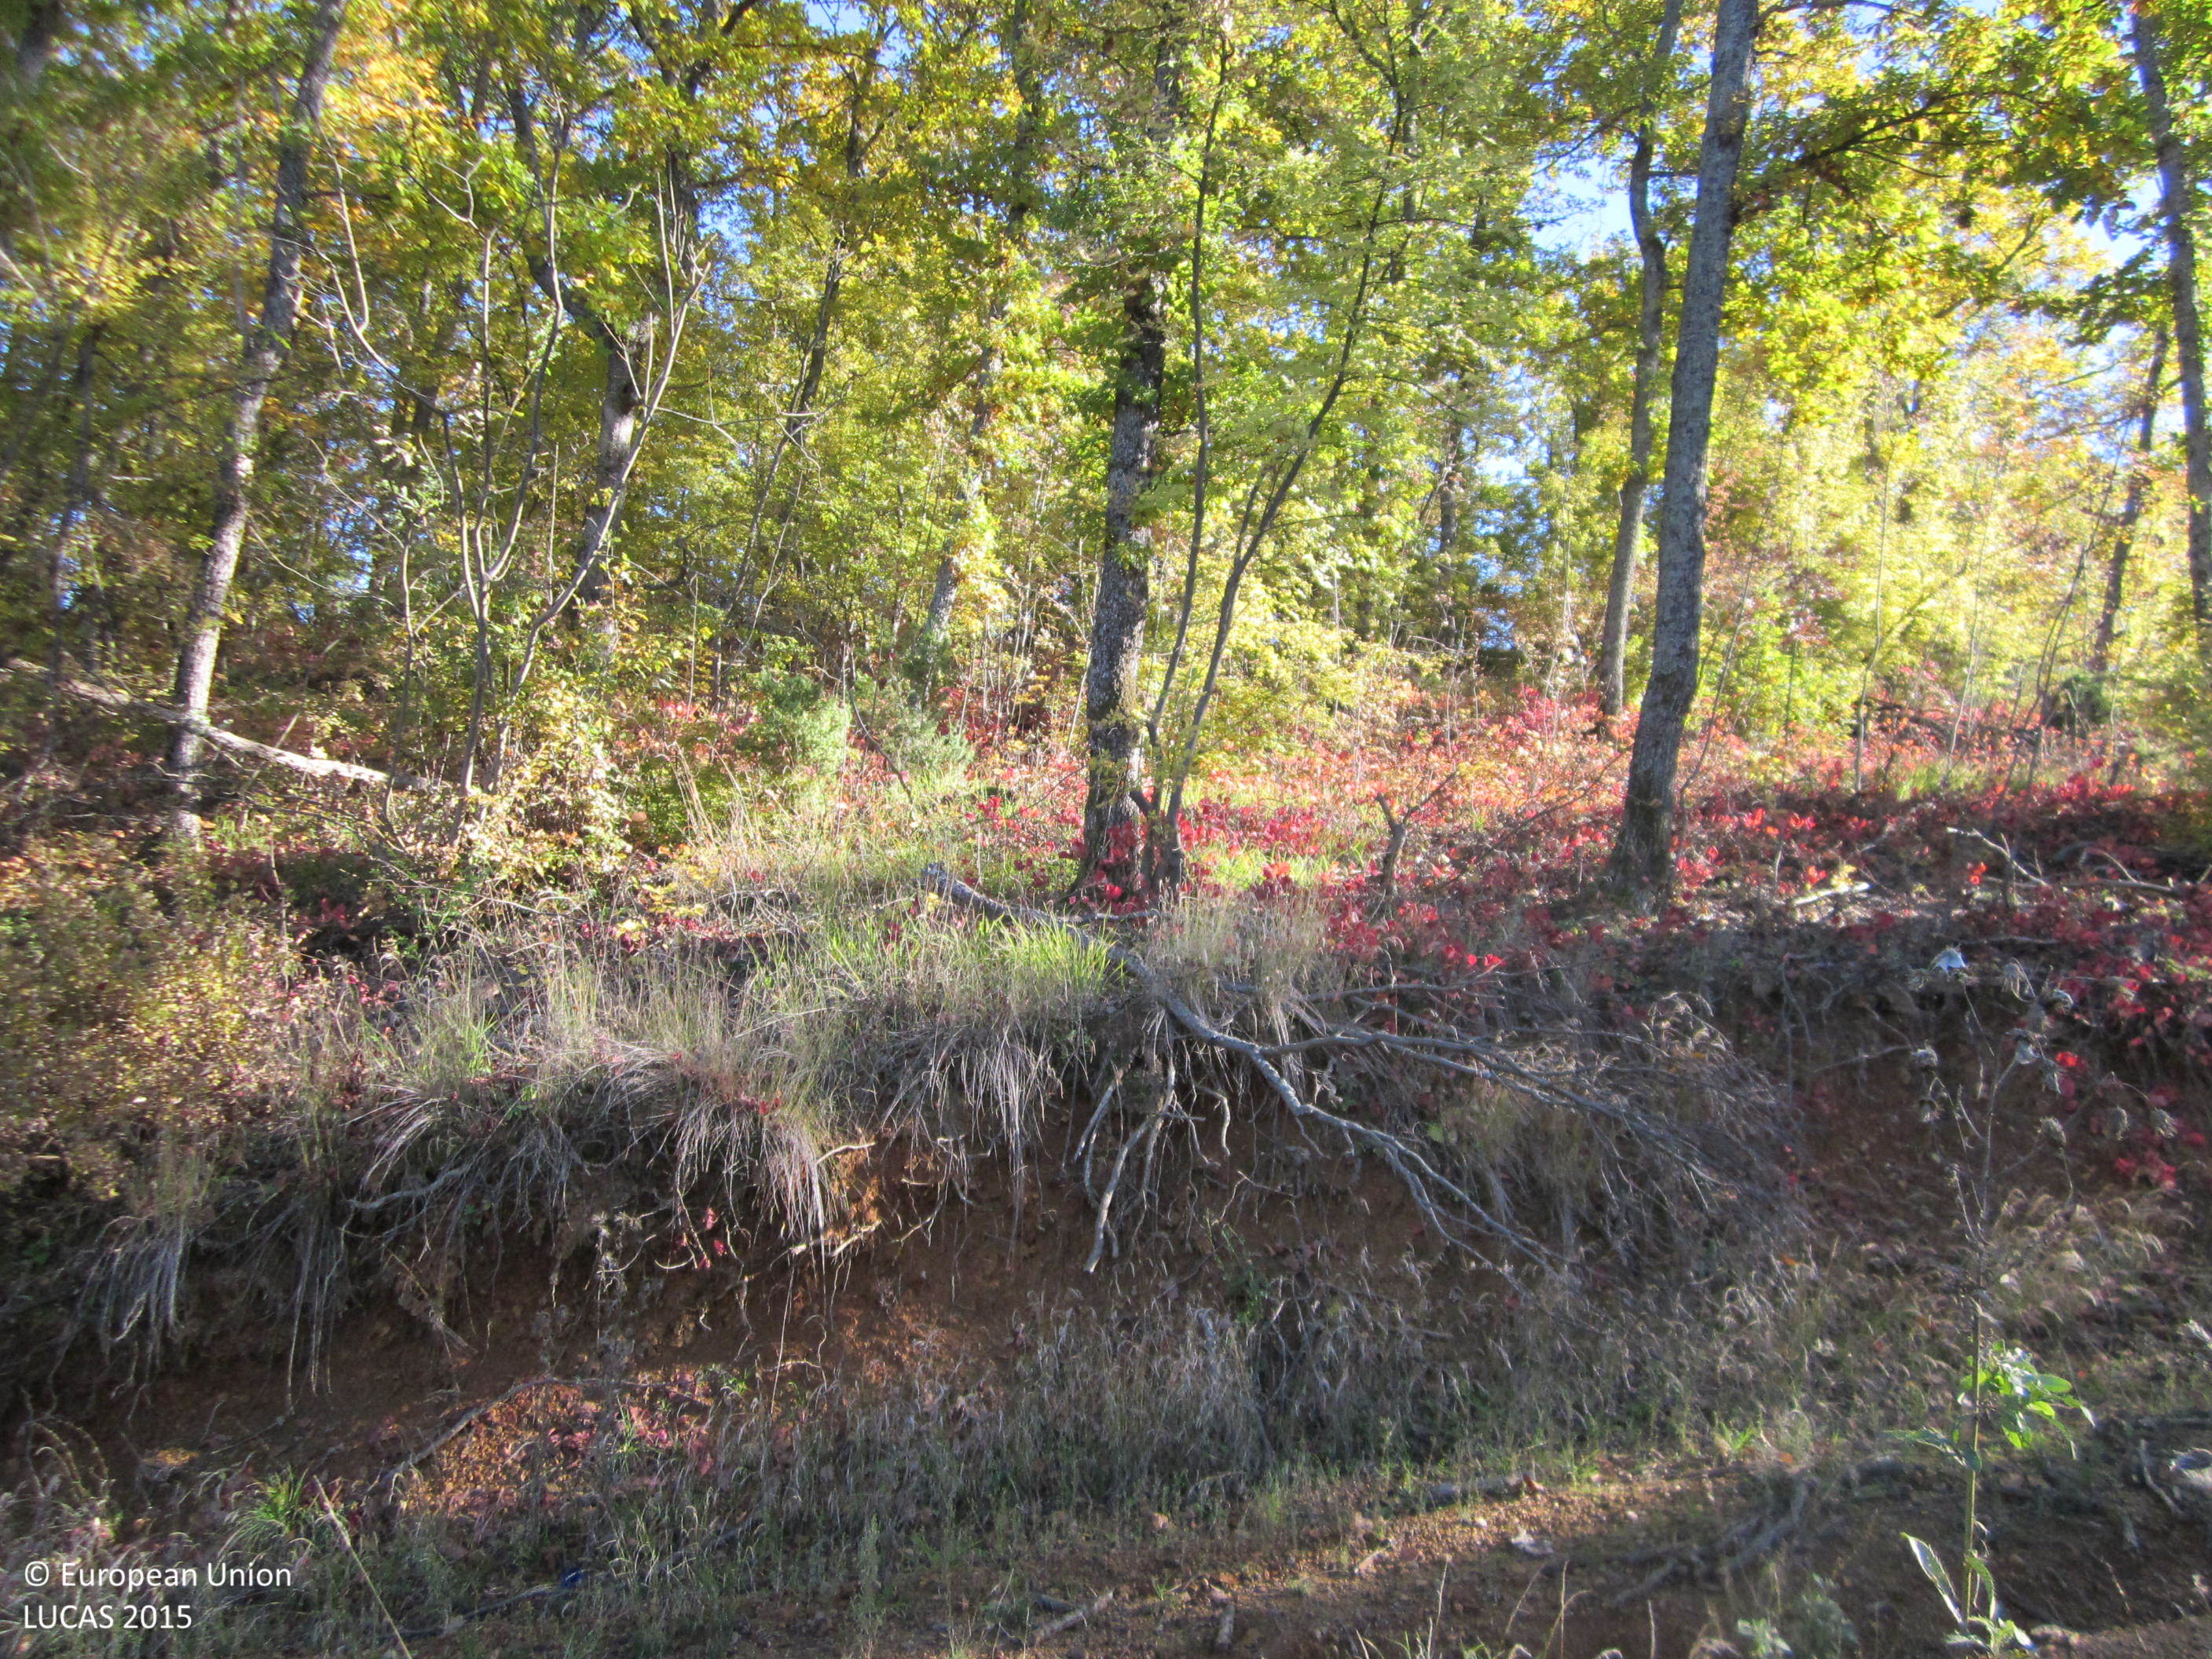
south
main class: Woodland
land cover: Broadleaved woodland
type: mesophytic deciduous forest
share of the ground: > 75 %
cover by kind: broadleaved forest trees 80 %, shrubs 10 %, herbaceous plants 10 %
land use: Forestry
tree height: > 5 m
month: November
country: BG
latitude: 41.6112
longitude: 25.7725
